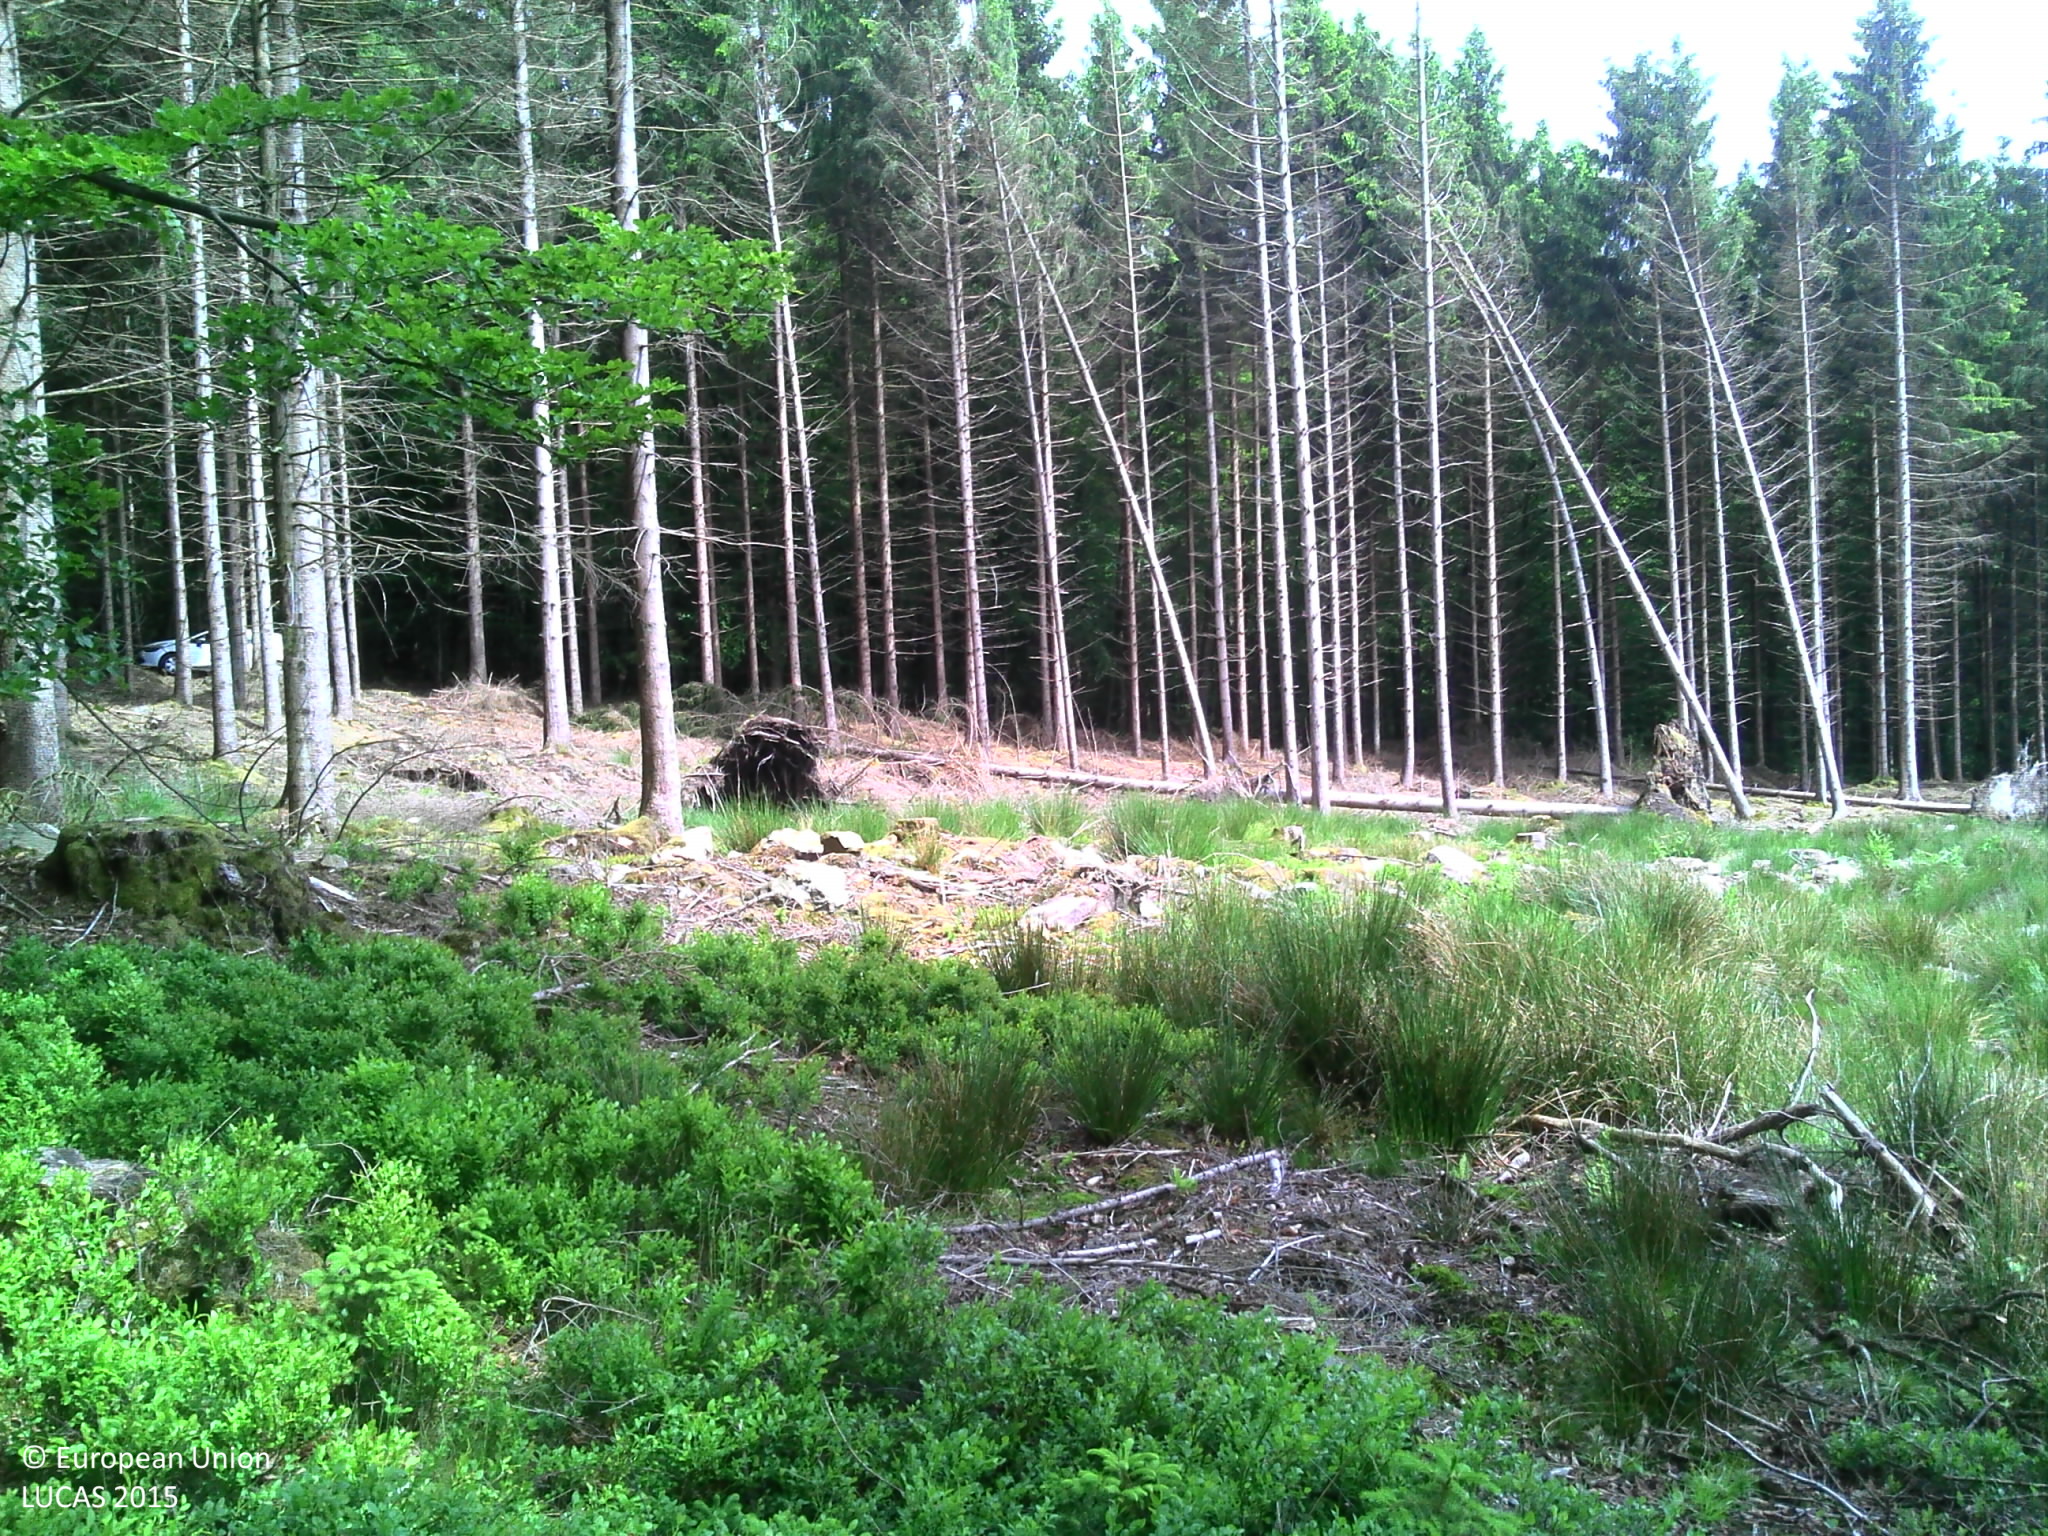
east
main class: Shrubland
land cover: Shrubland without tree cover
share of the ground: > 75 %
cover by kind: herbaceous plants 45 %, shrubs 25 %, unconsolidated bare surface 15 %
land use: Forestry
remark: Clear cut
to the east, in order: Shrubland without tree cover; Spruce dominated coniferous woodland; Tracks; Broadleaved woodland; Rivers and streams; Tracks; Spruce dominated coniferous woodland
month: June
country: BE
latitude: 50.3578
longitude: 5.7678
